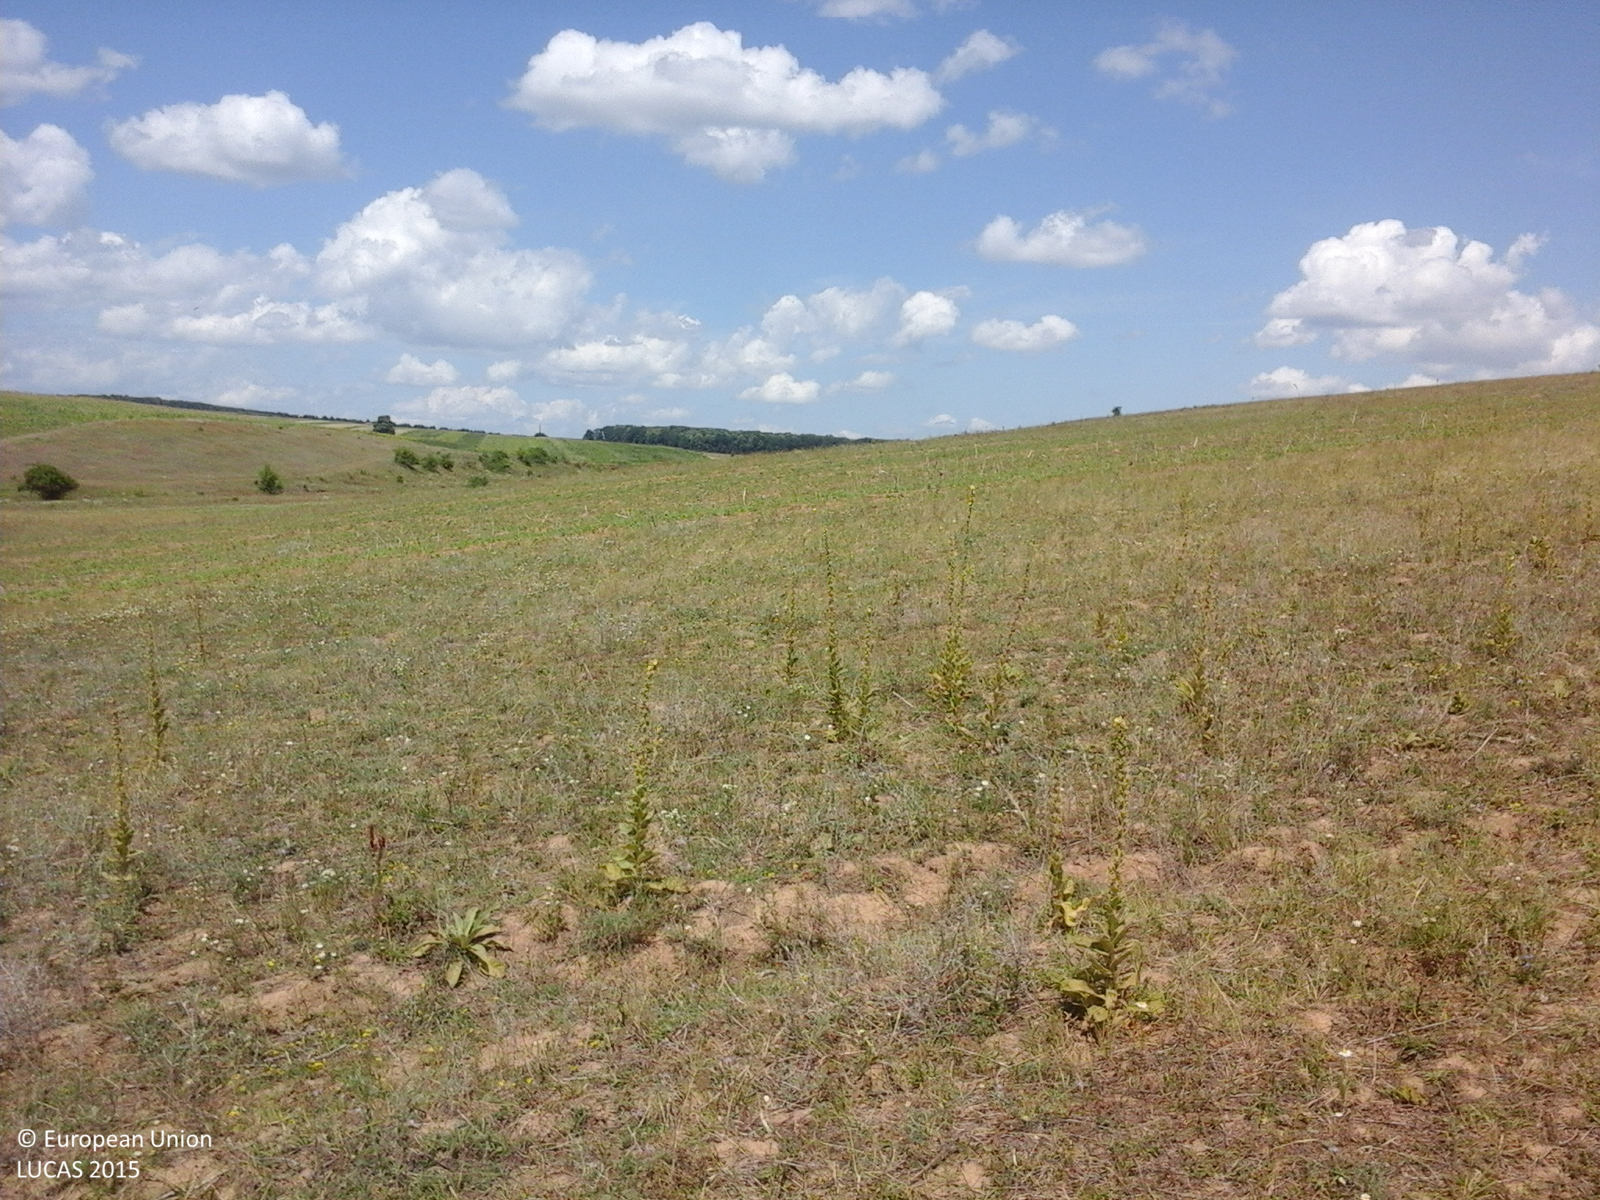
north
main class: Grassland
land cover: Grassland without tree/shrub cover
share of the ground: > 75 %
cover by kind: herbaceous plants 100 %
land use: Agriculture (excluding fallow land and kitchen gardens)
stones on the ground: < 10 %
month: July
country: RO
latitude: 46.1961
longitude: 27.8593
